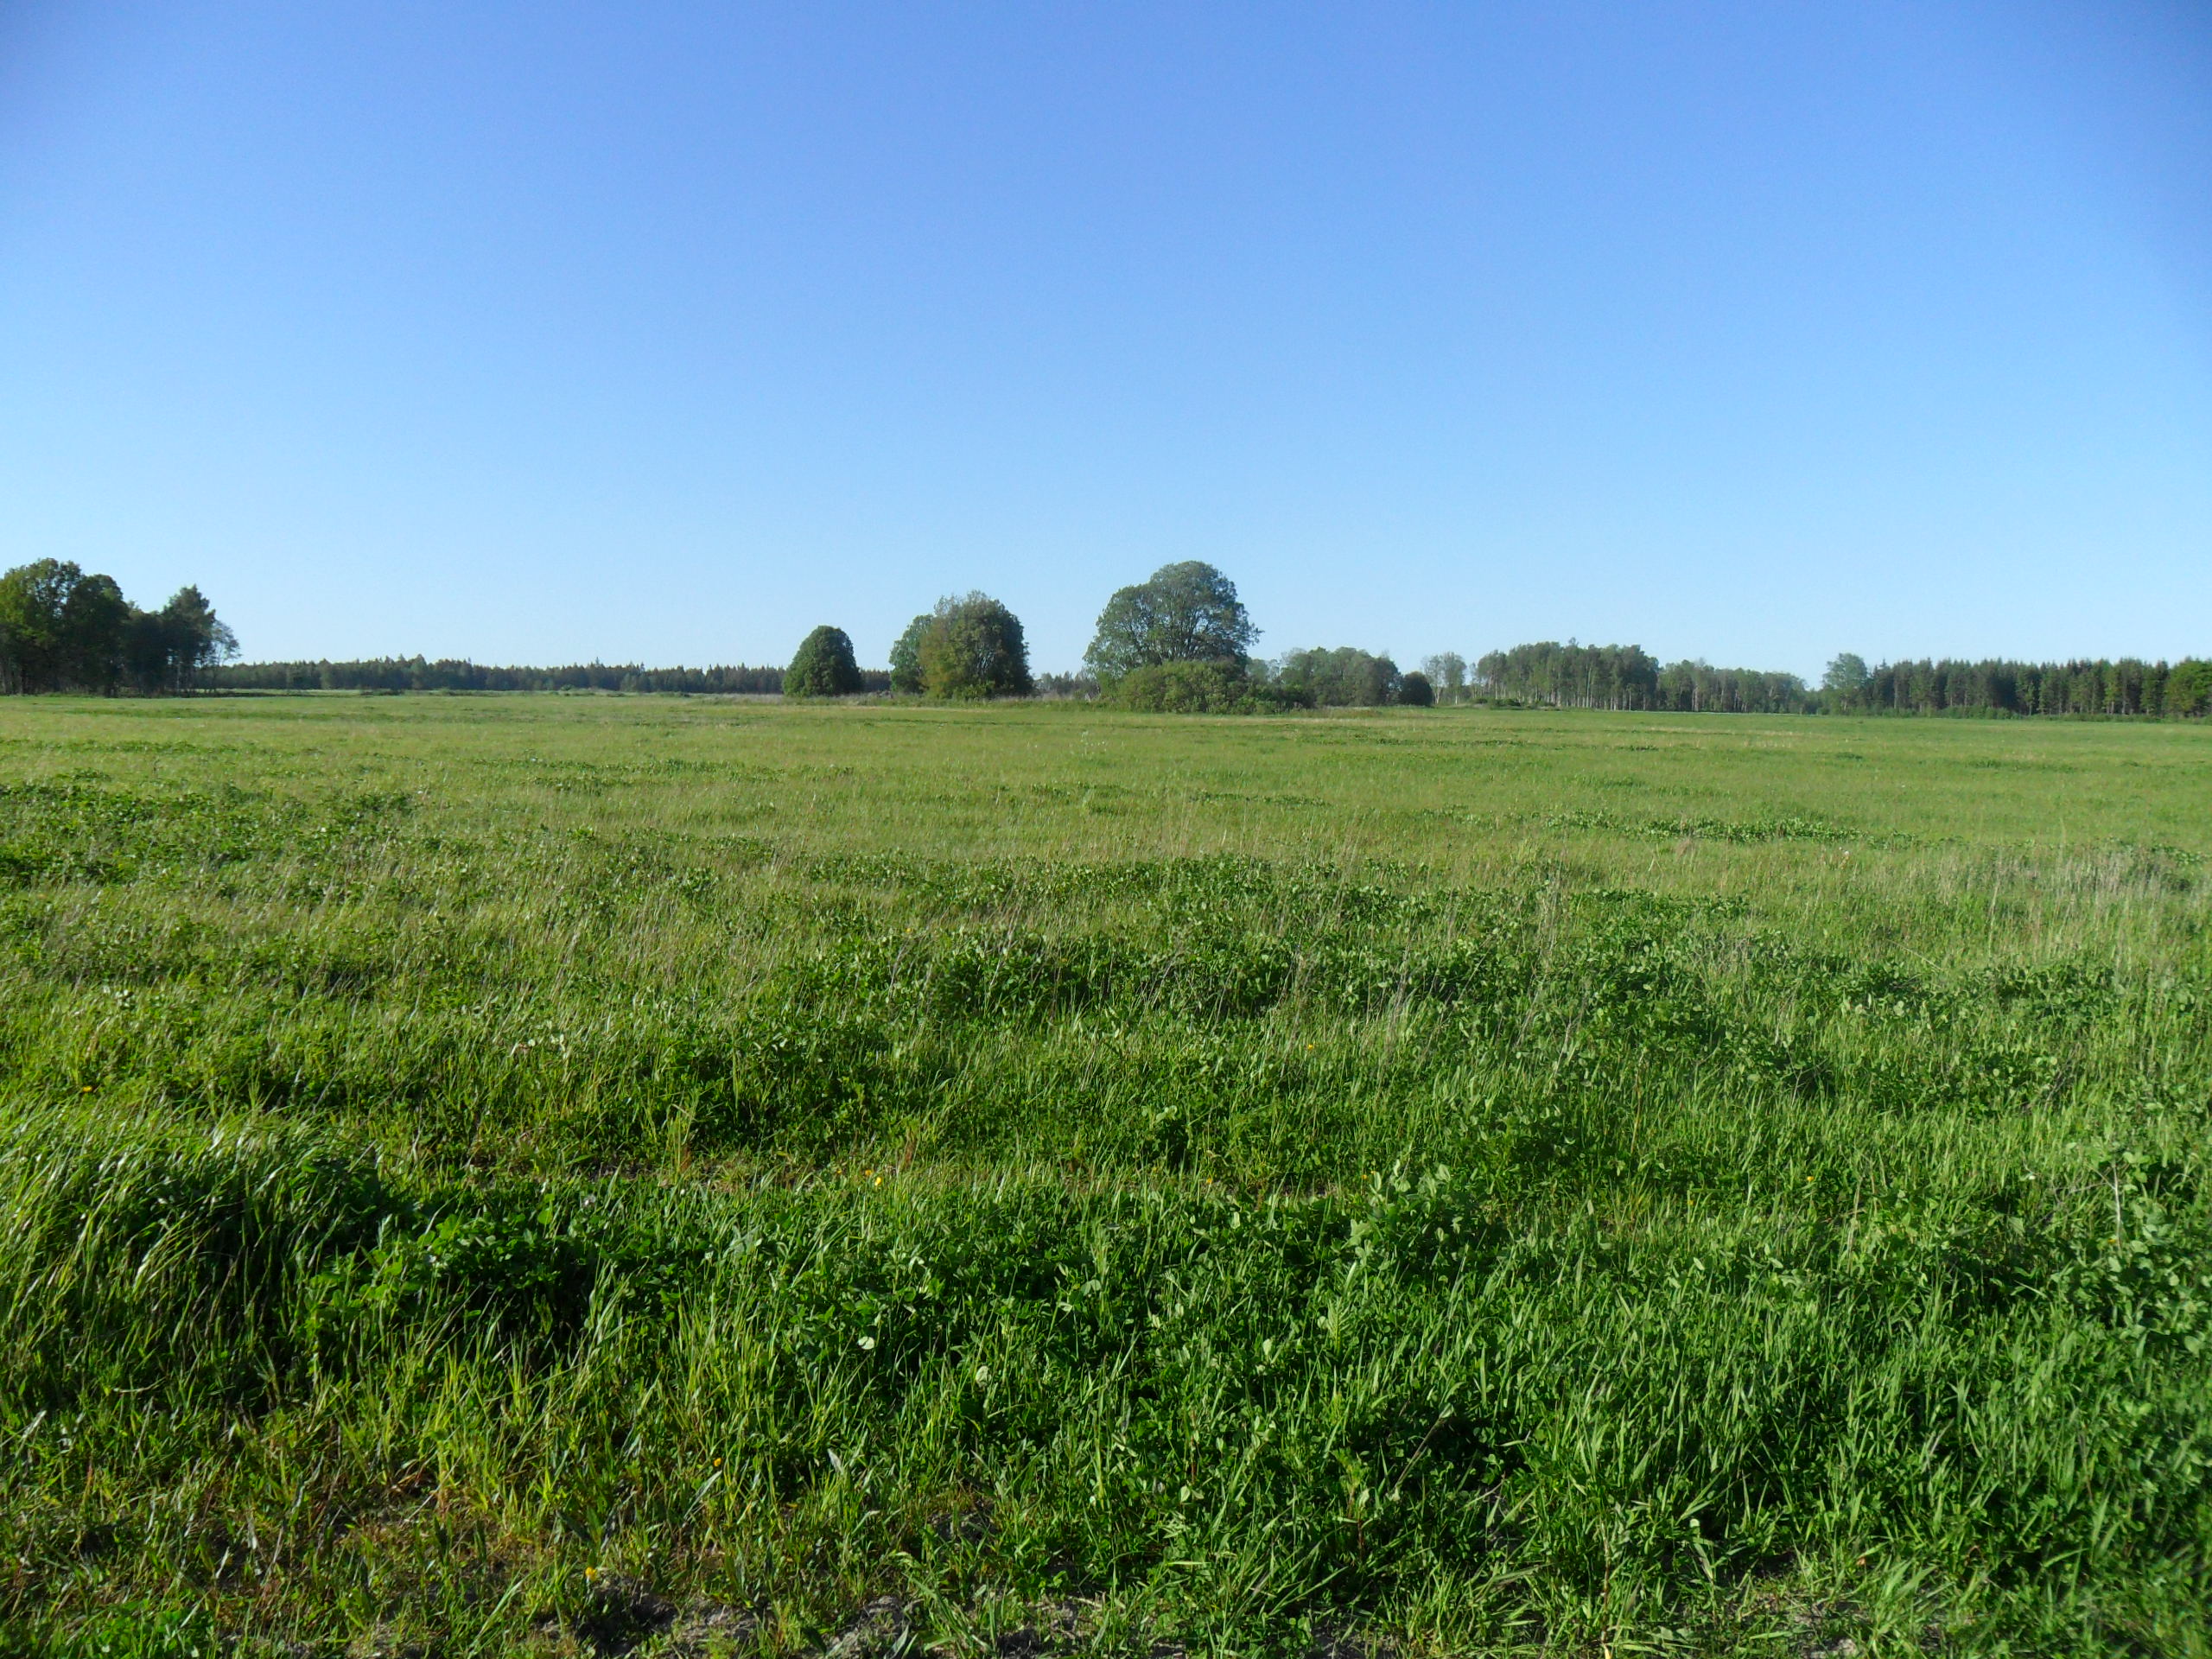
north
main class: Grassland
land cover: Grassland without tree/shrub cover
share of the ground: > 75 %
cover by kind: herbaceous plants 85 %, unconsolidated bare surface 5 %
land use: Agriculture (excluding fallow land and kitchen gardens)
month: June
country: LV
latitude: 57.5752
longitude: 22.3402
